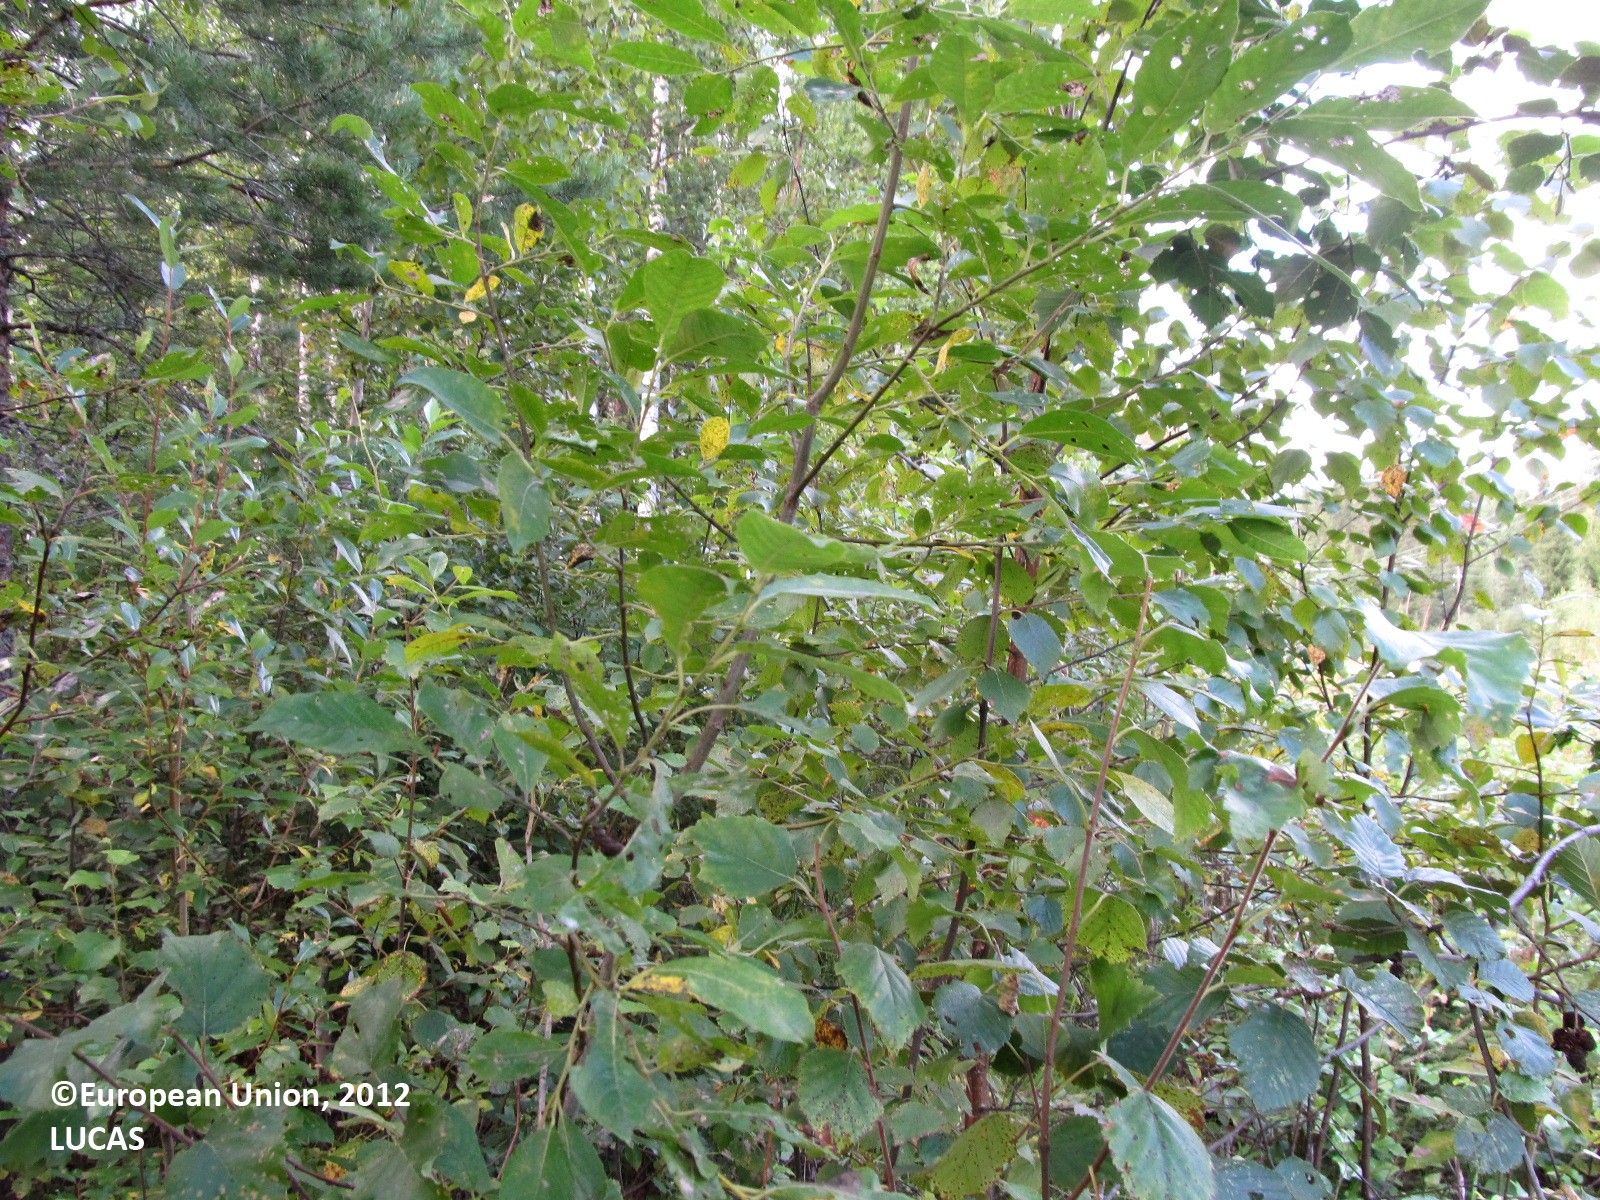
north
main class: Woodland
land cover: Pine dominated mixed woodland
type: boreal forest
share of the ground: 50 - 75 %
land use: Forestry
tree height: > 5 m
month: August
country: FI
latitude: 62.3108
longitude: 28.3103
